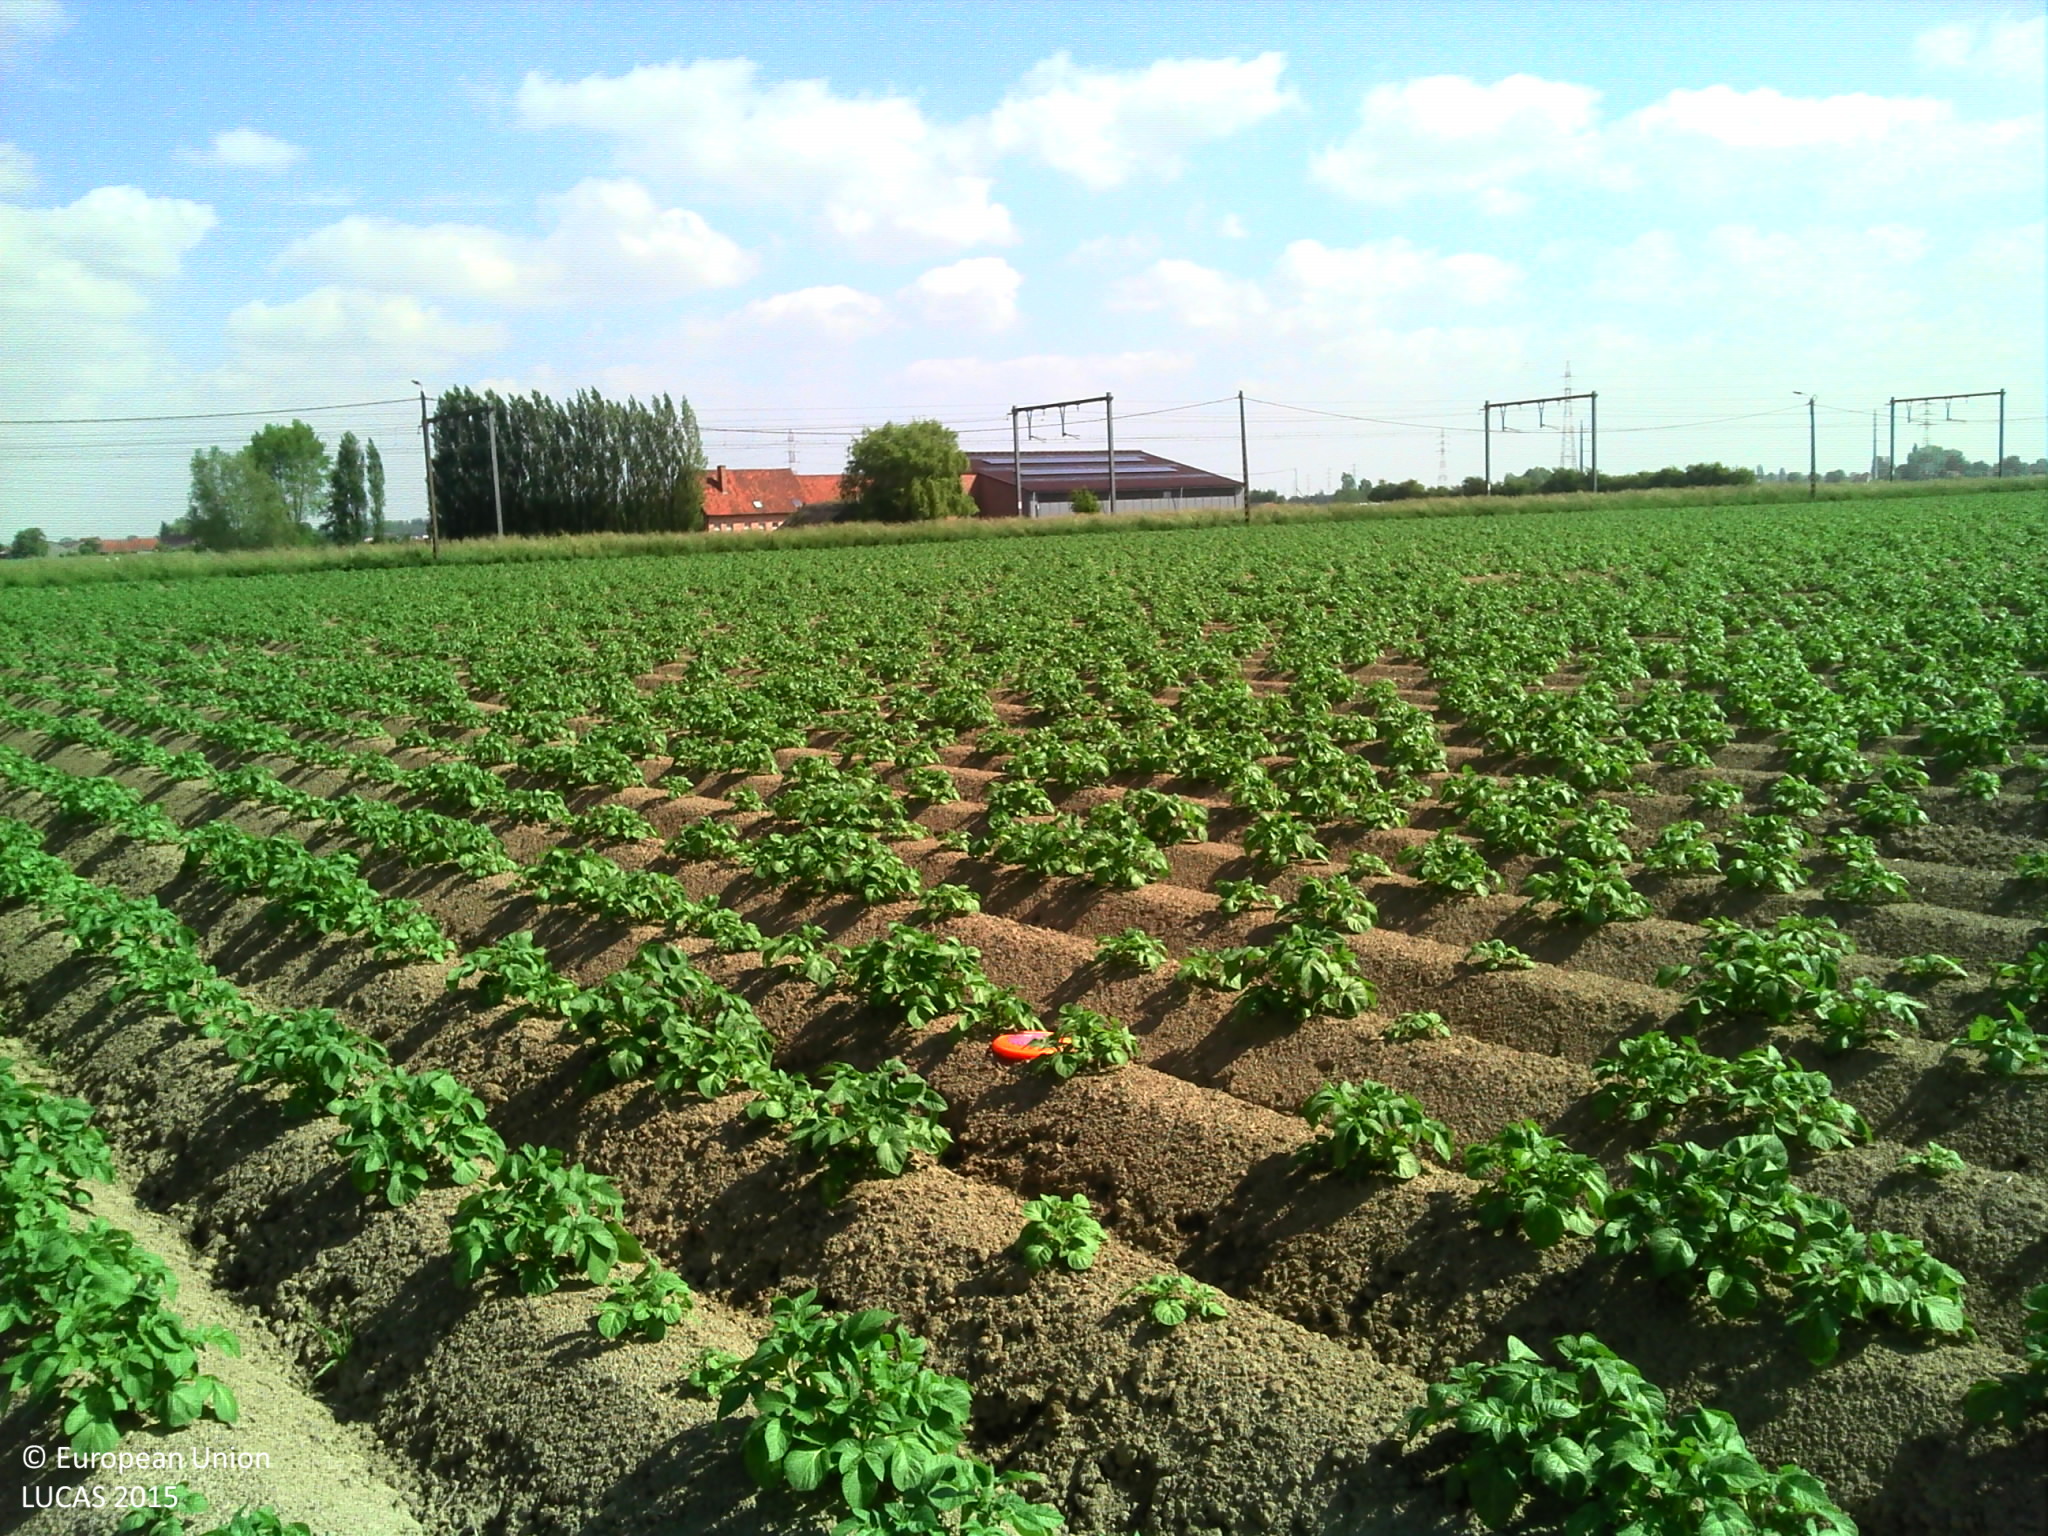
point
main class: Cropland
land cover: Potatoes
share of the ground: 10 - 25 %
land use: Agriculture (excluding fallow land and kitchen gardens)
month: June
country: BE
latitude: 50.8075
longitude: 3.1364
